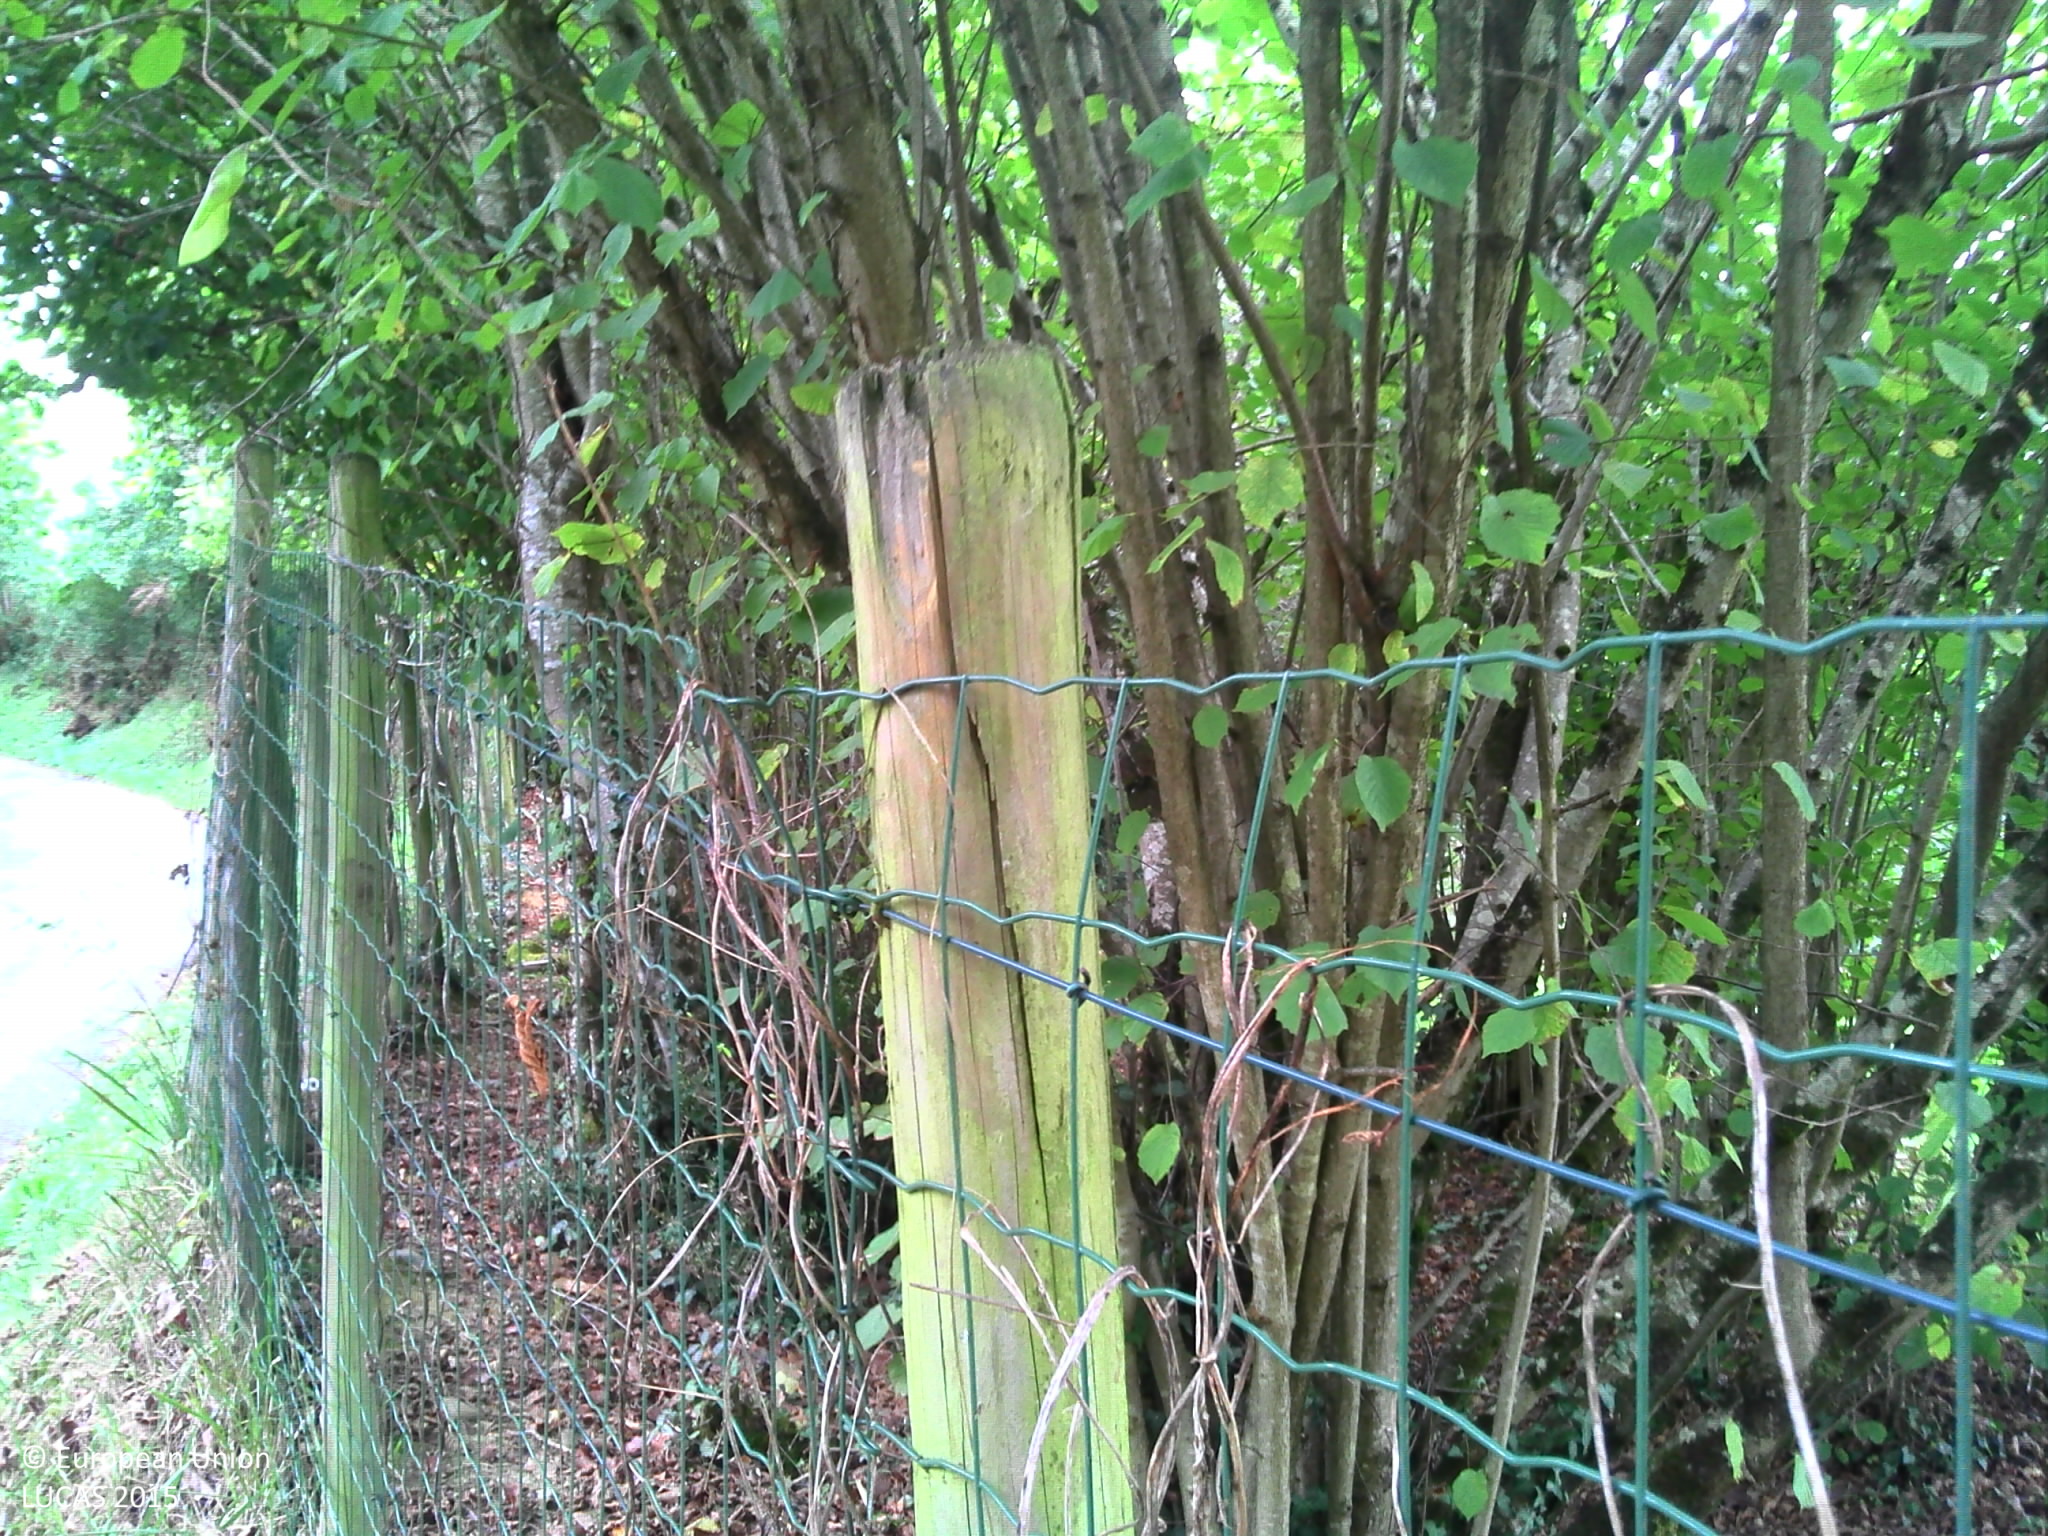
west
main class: Grassland
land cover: Grassland without tree/shrub cover
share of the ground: > 75 %
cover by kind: herbaceous plants 100 %
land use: Residential
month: September
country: FR
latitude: 43.3253
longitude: -0.5025
